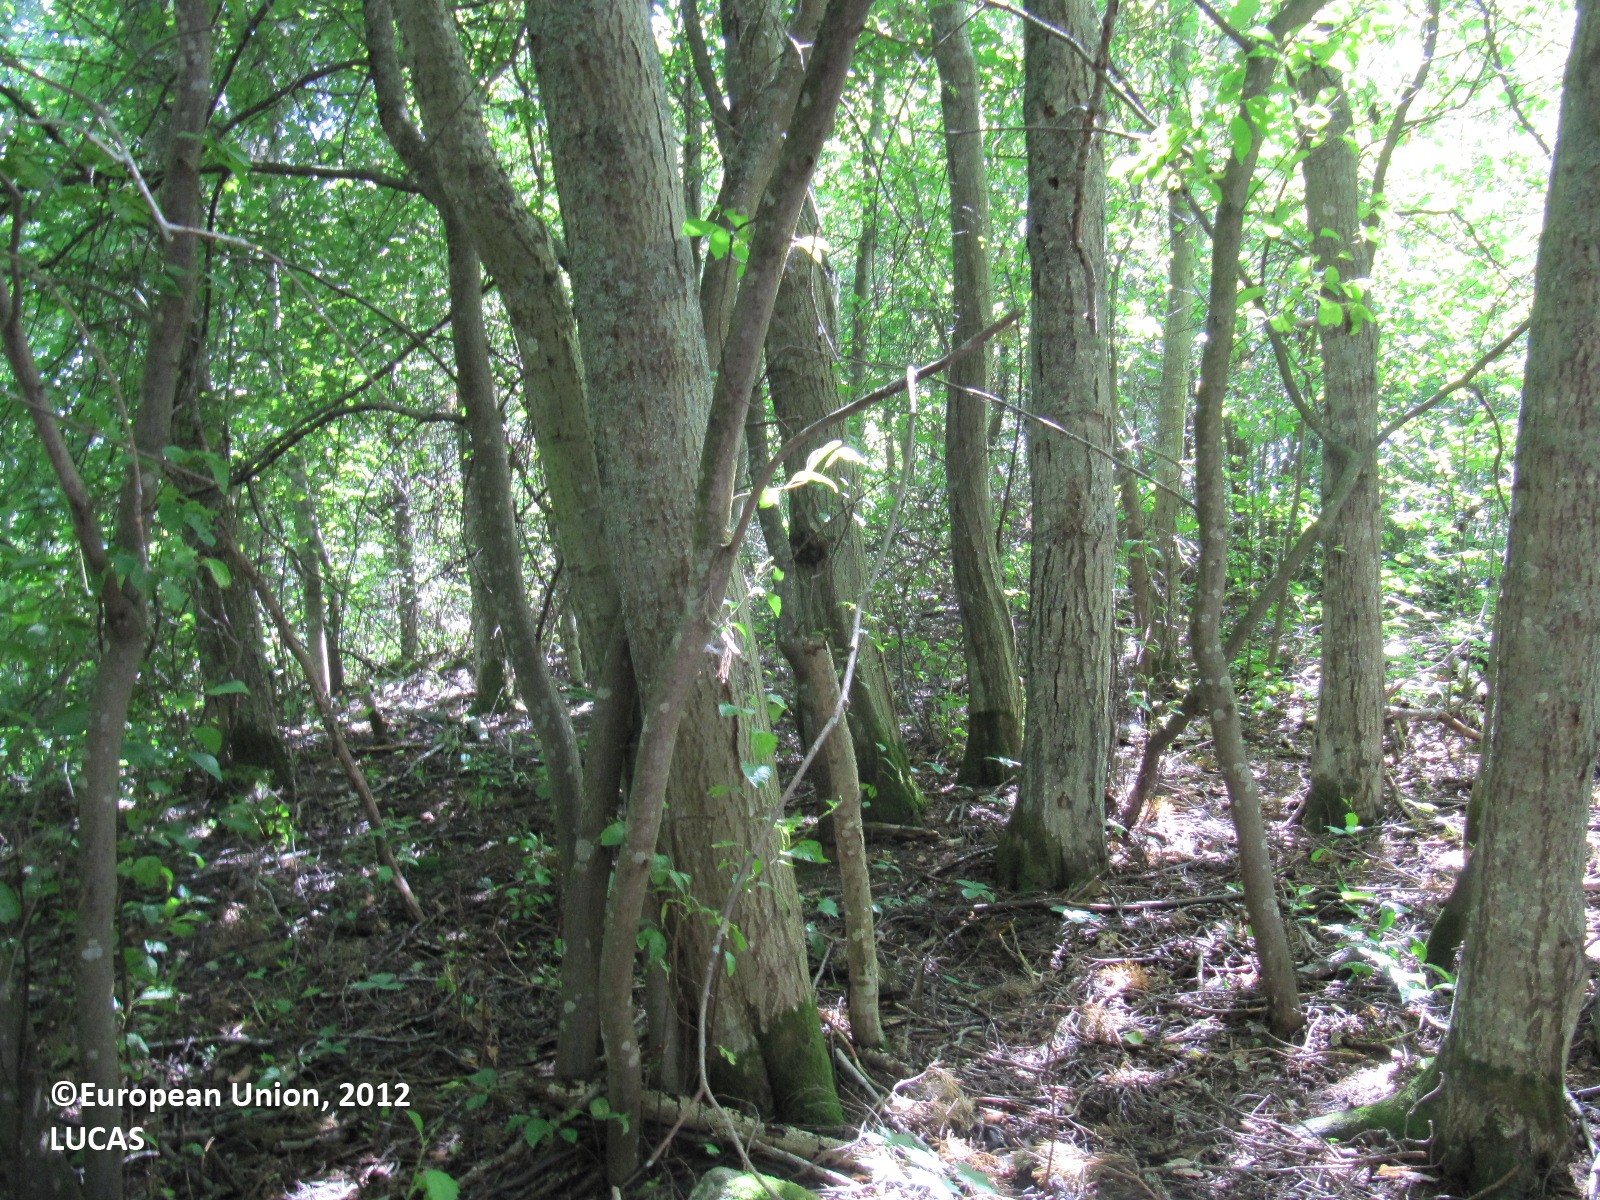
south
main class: Woodland
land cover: Broadleaved woodland
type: boreal forest
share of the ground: > 75 %
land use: Forestry
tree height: > 5 m
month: July
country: FI
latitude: 61.1654
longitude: 24.5447
